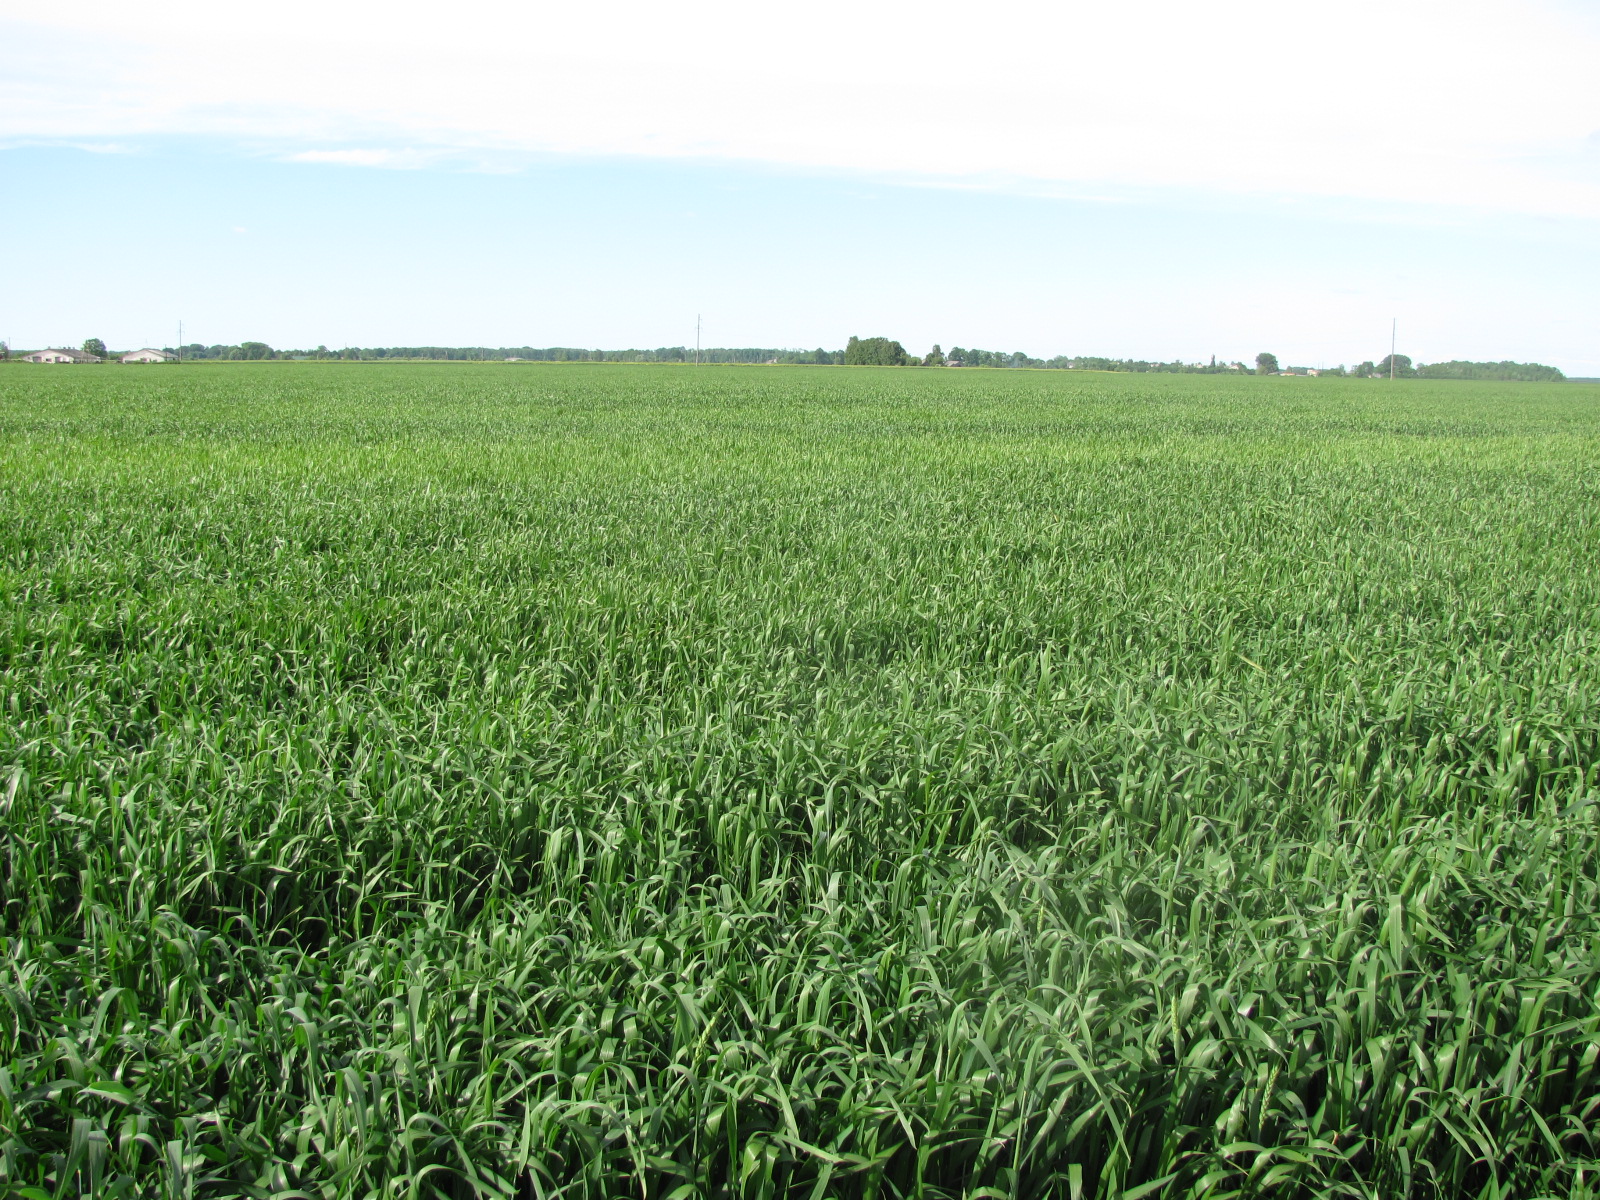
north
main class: Cropland
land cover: Common wheat
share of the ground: > 75 %
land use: Agriculture (excluding fallow land and kitchen gardens)
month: June
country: LV
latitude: 56.5457
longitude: 23.8584
